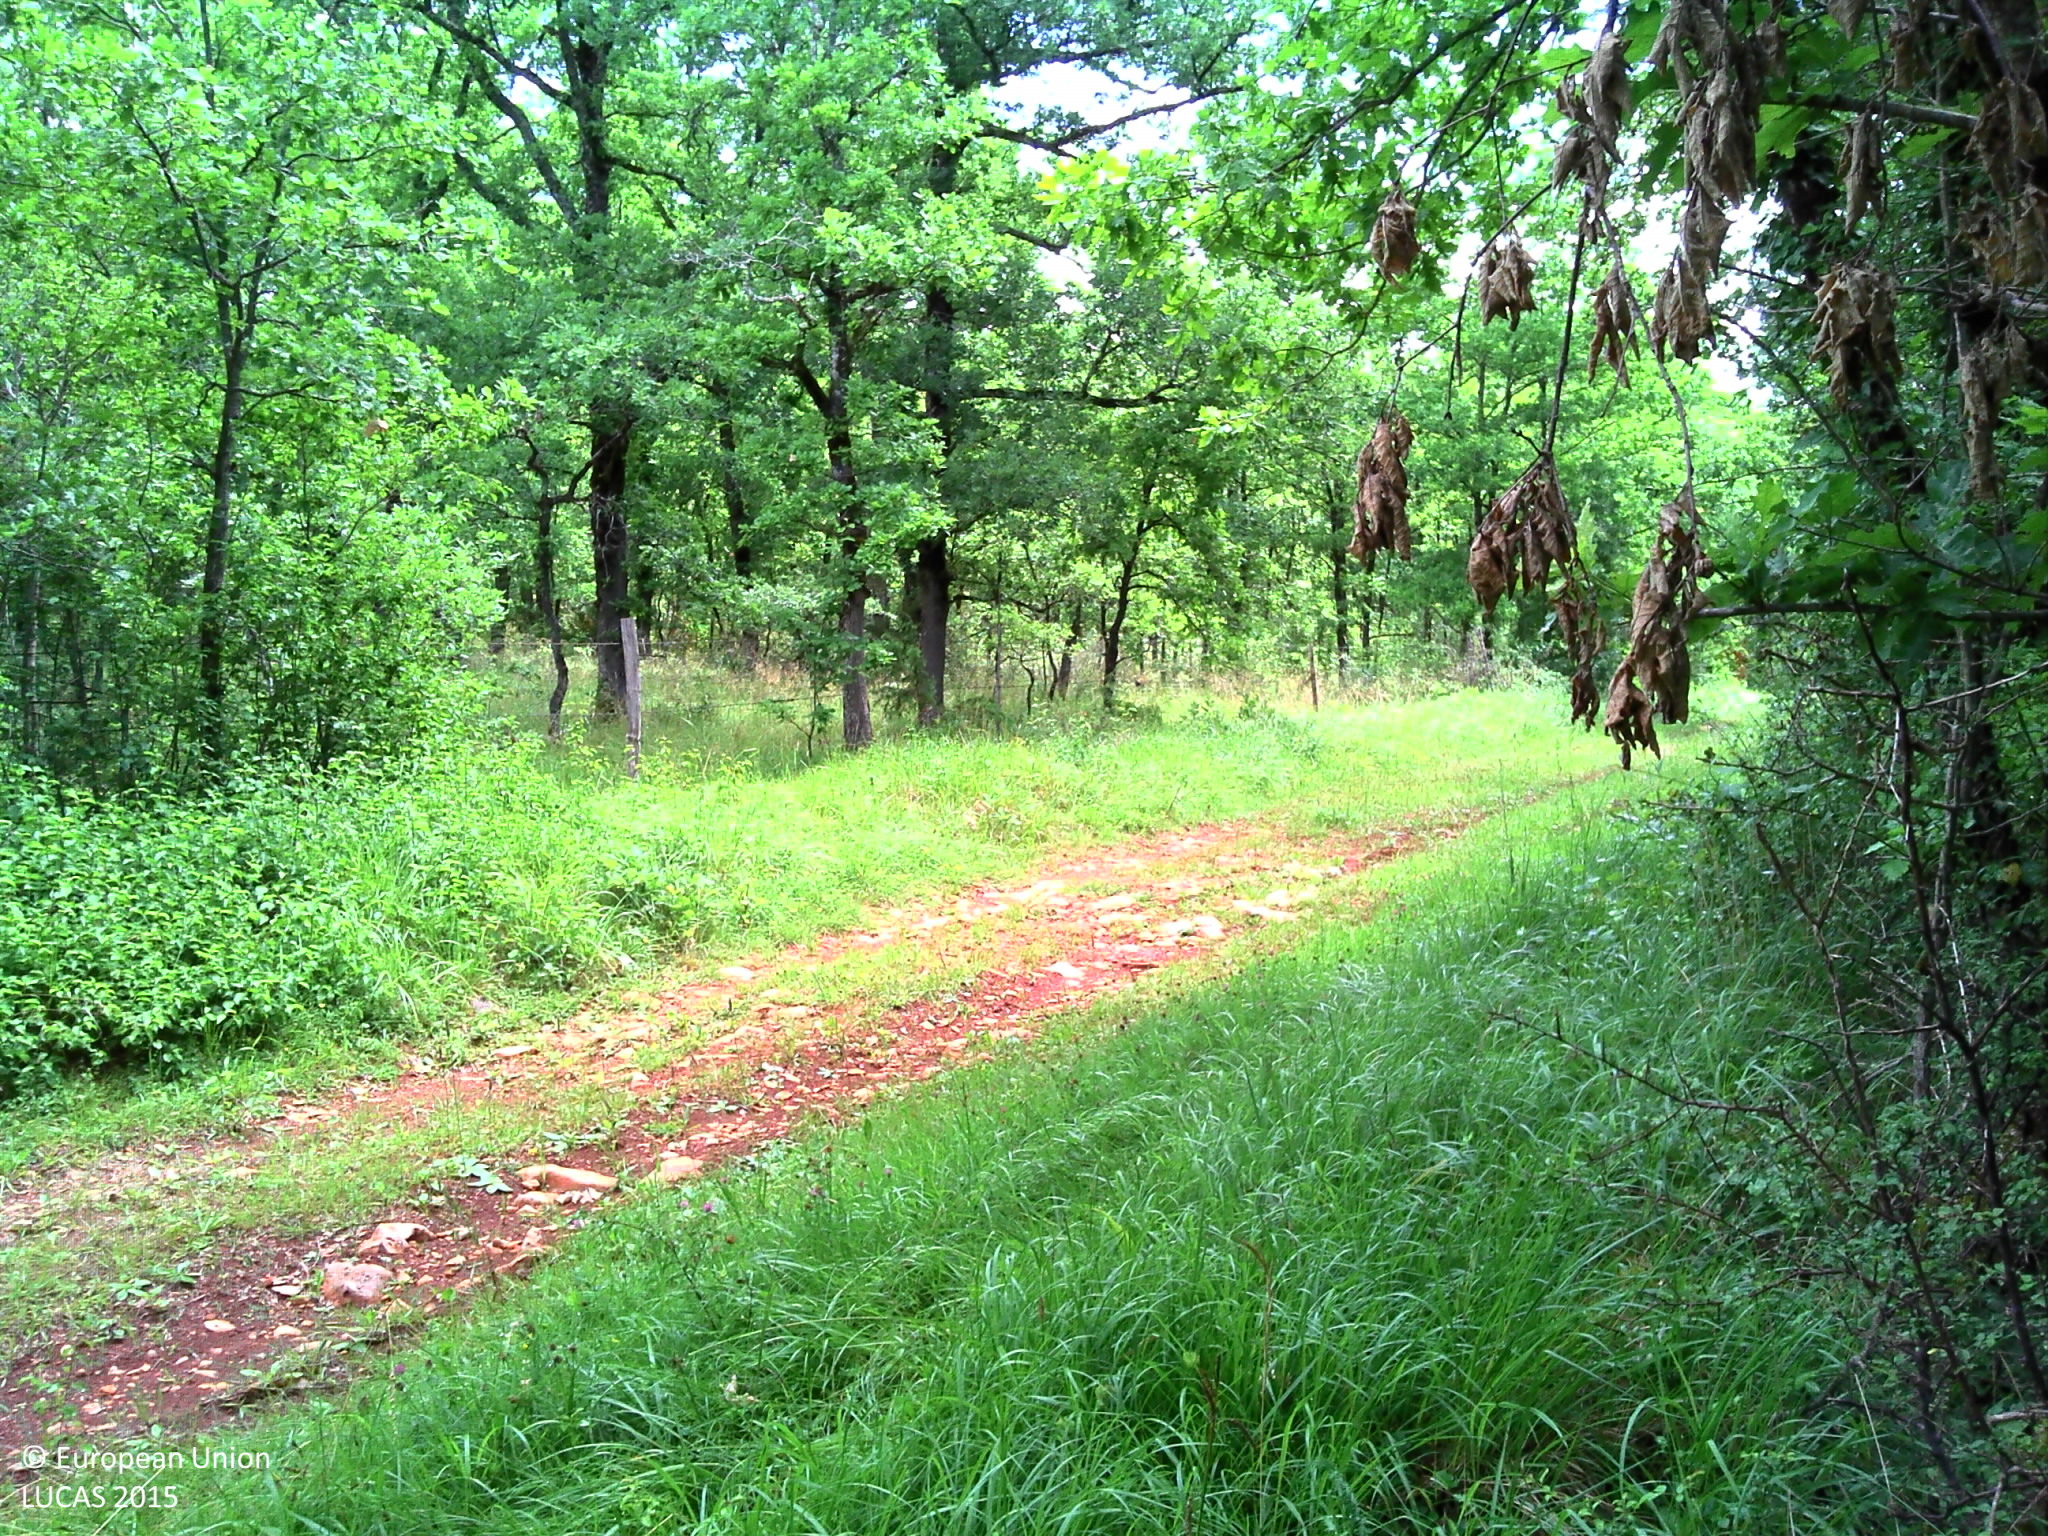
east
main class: Woodland
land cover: Broadleaved woodland
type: acidophilous oak and oak-birch forest
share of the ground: > 75 %
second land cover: Grassland without tree/shrub cover
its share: > 75 %
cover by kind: broadleaved forest trees 85 %, shrubs 10 %, herbaceous plants 5 %
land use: Forestry
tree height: > 5 m
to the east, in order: Broadleaved woodland; Grassland without tree/shrub cover; Tracks; Grass margins; Fences; Broadleaved woodland
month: June
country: FR
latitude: 44.3404
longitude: 1.8856
